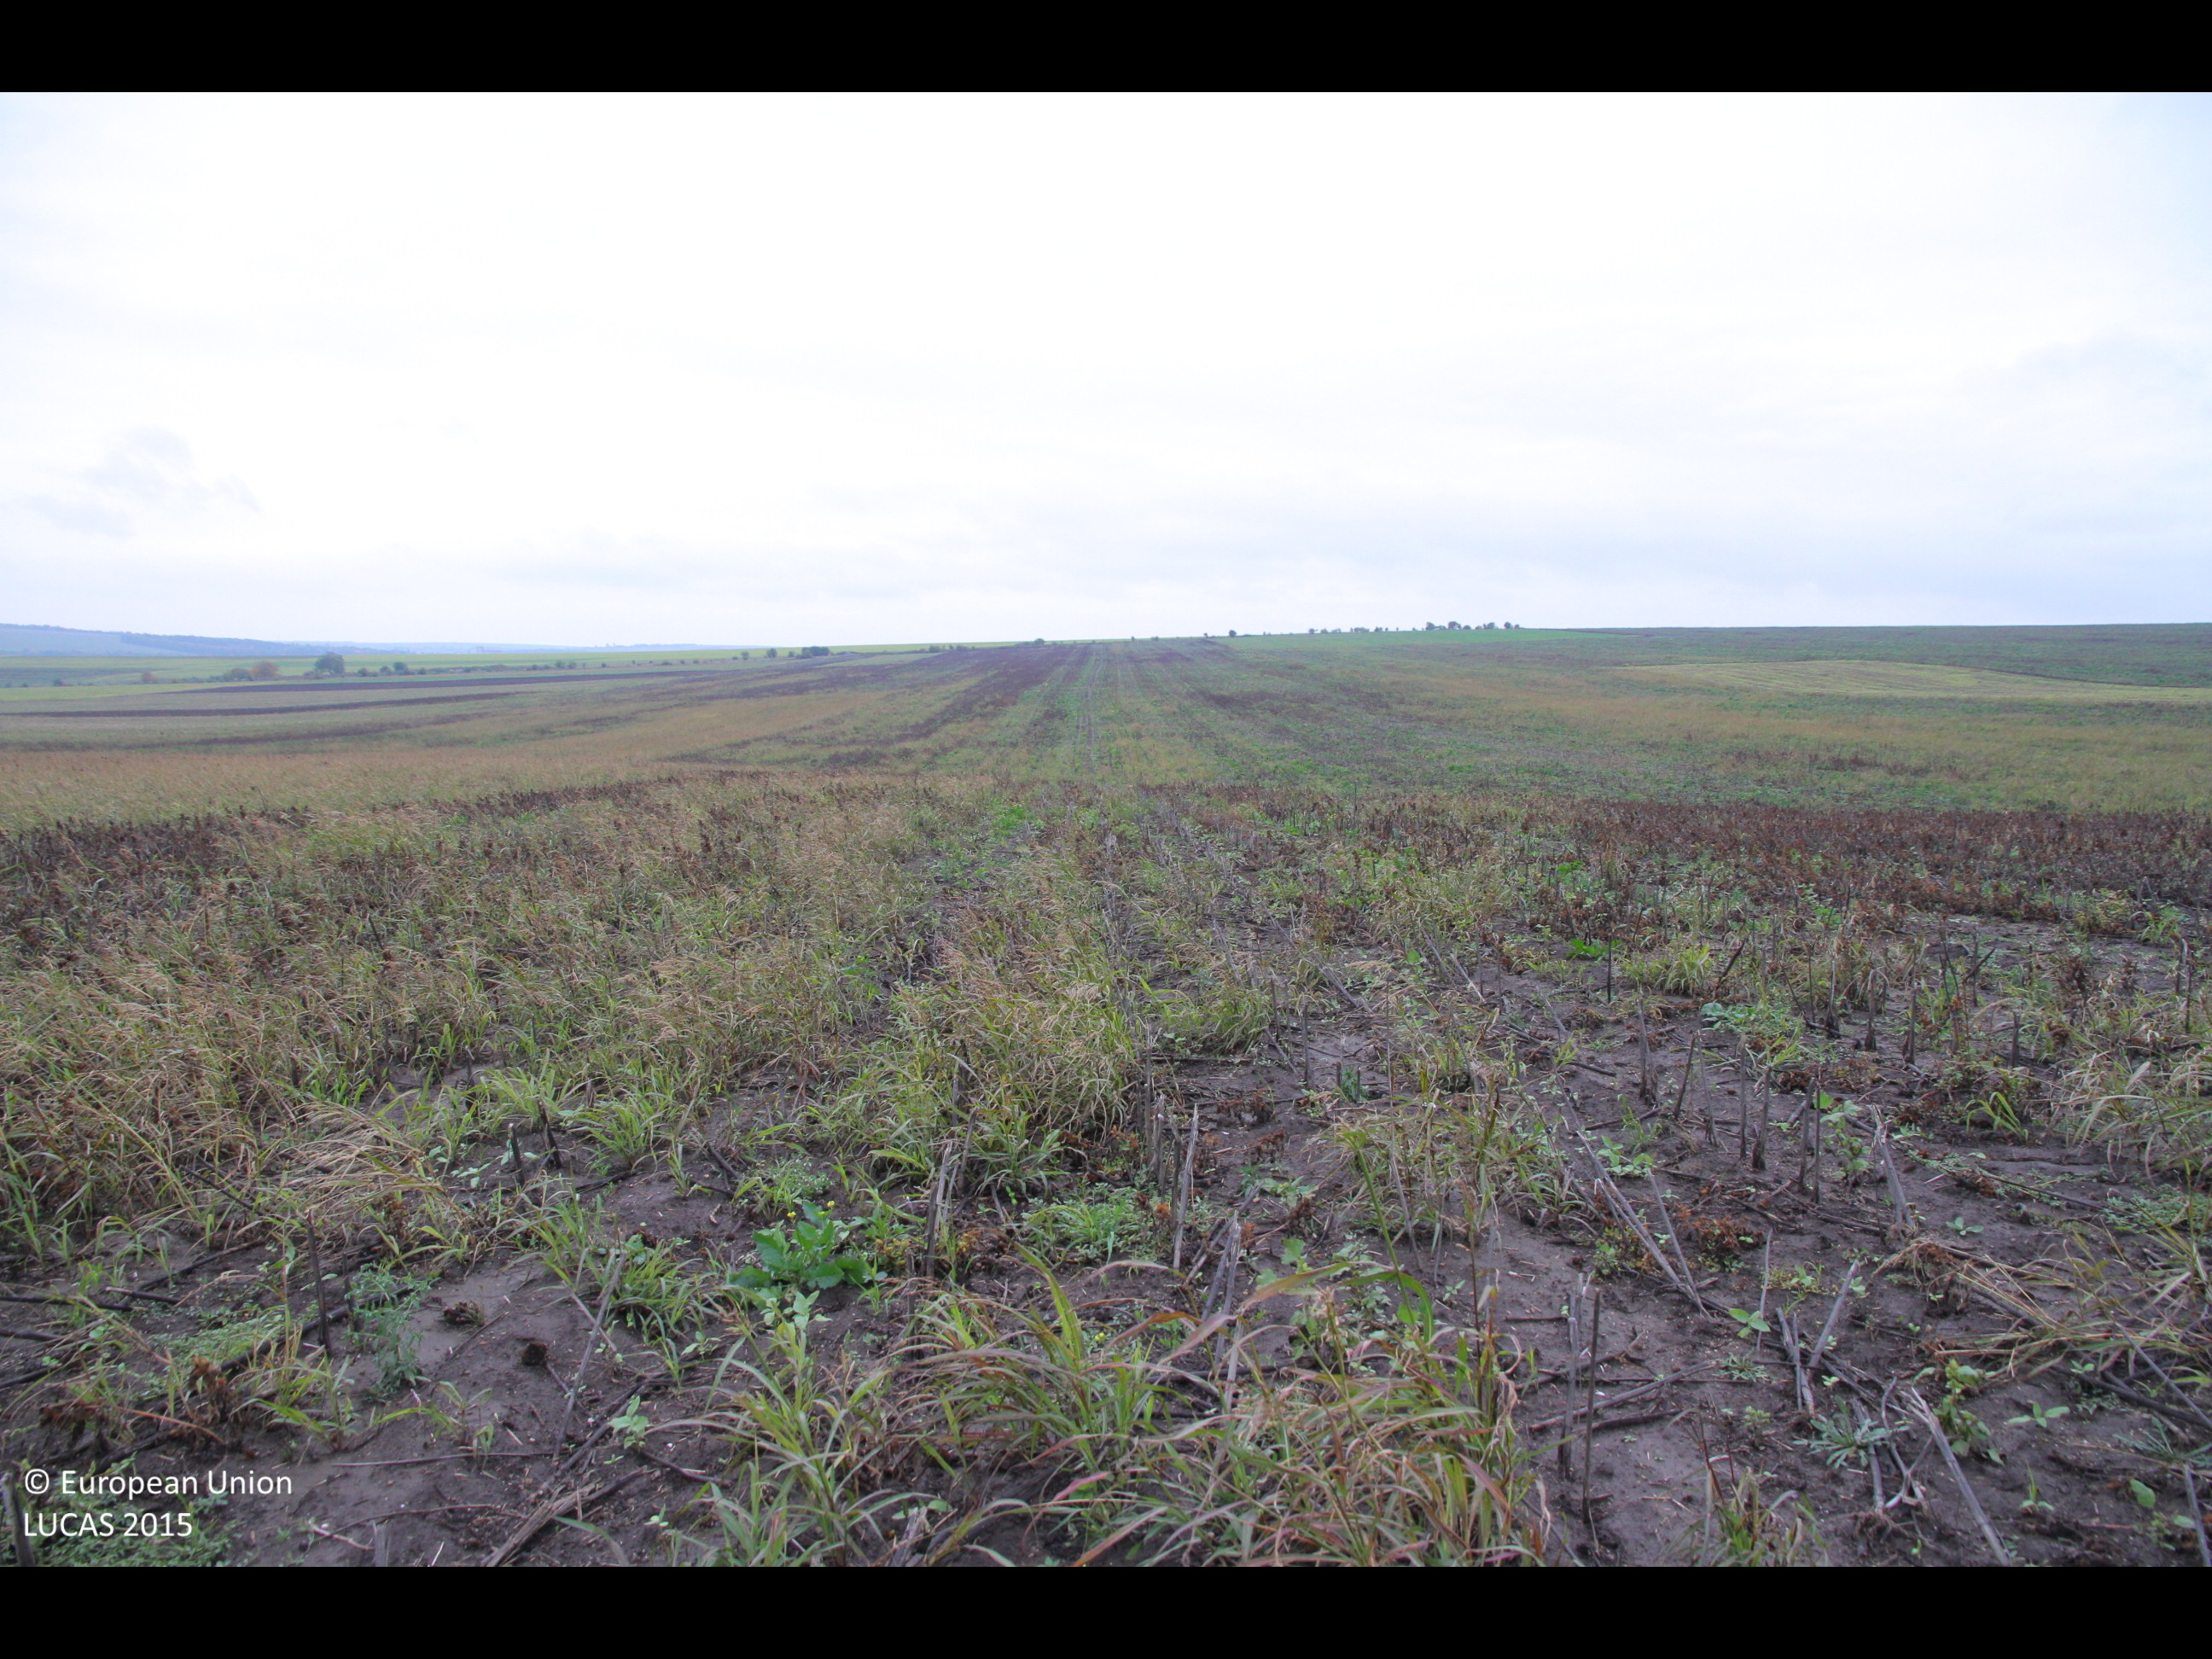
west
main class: Cropland
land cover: Sunflower
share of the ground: < 10 %
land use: Agriculture (excluding fallow land and kitchen gardens)
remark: Harvested field
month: October
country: BG
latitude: 43.4396
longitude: 26.9556
